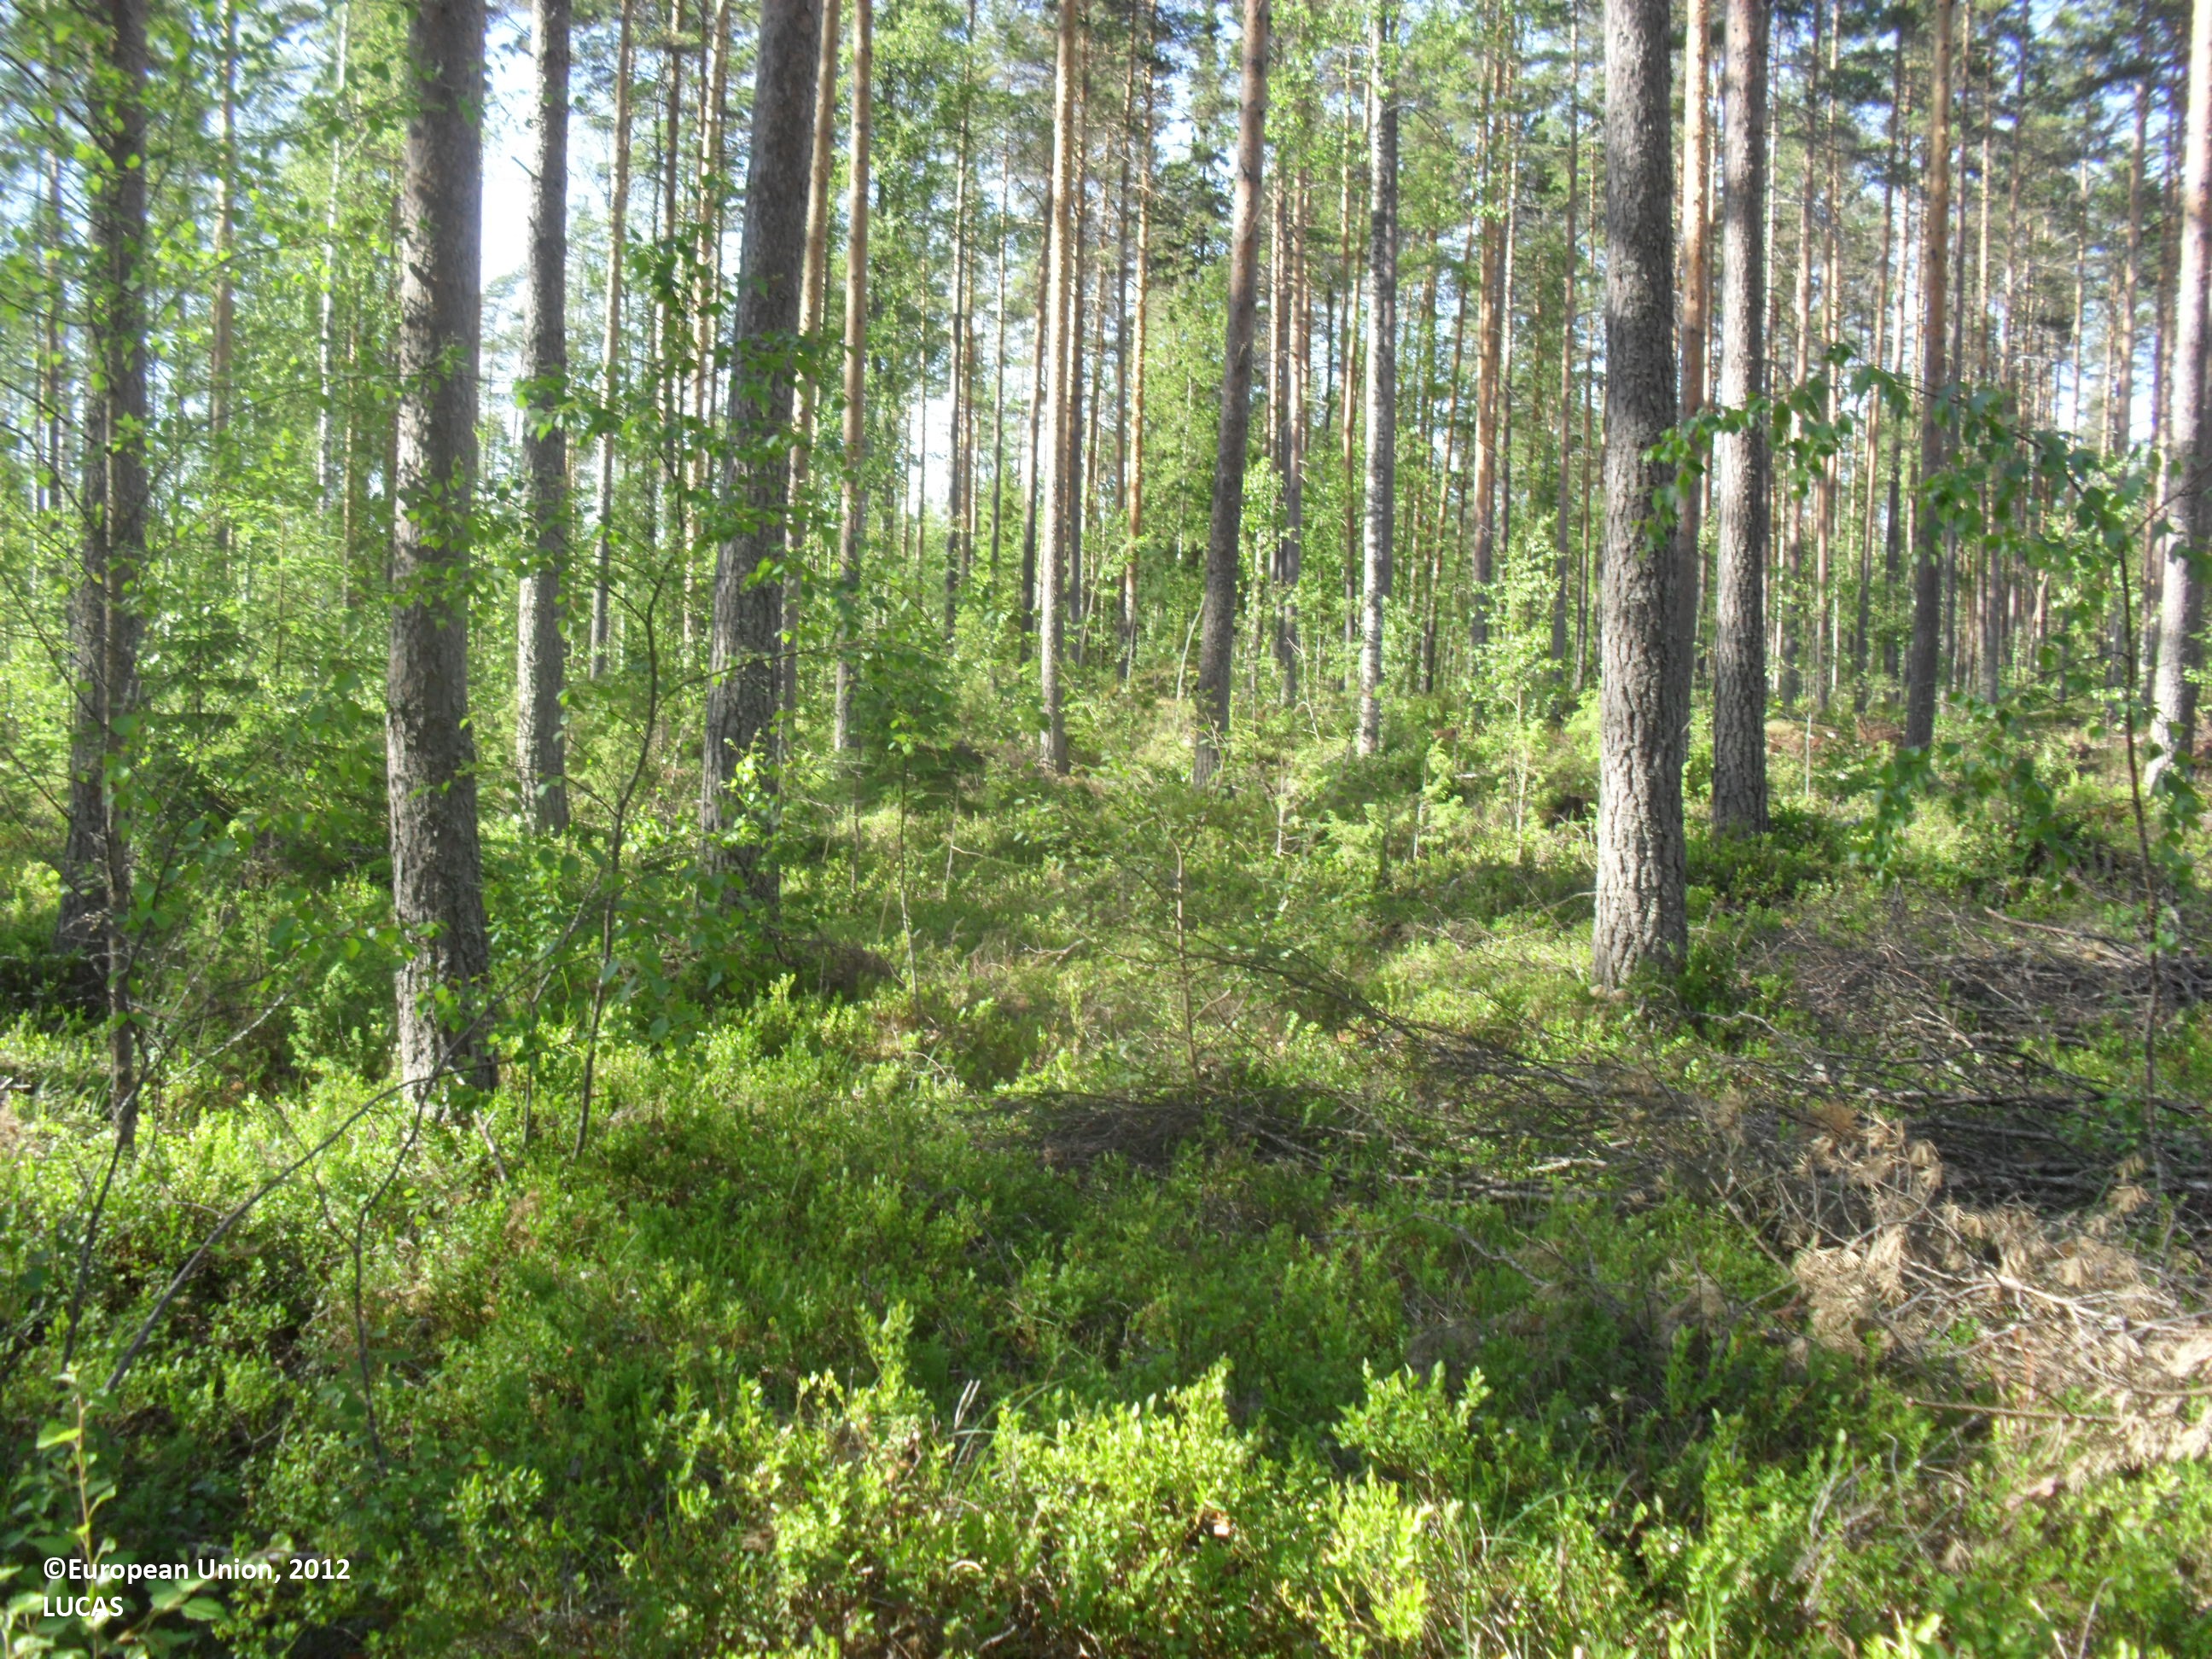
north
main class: Woodland
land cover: Pine dominated mixed woodland
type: boreal forest
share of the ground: 50 - 75 %
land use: Forestry
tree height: > 5 m
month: June
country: FI
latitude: 62.9665
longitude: 23.7778
